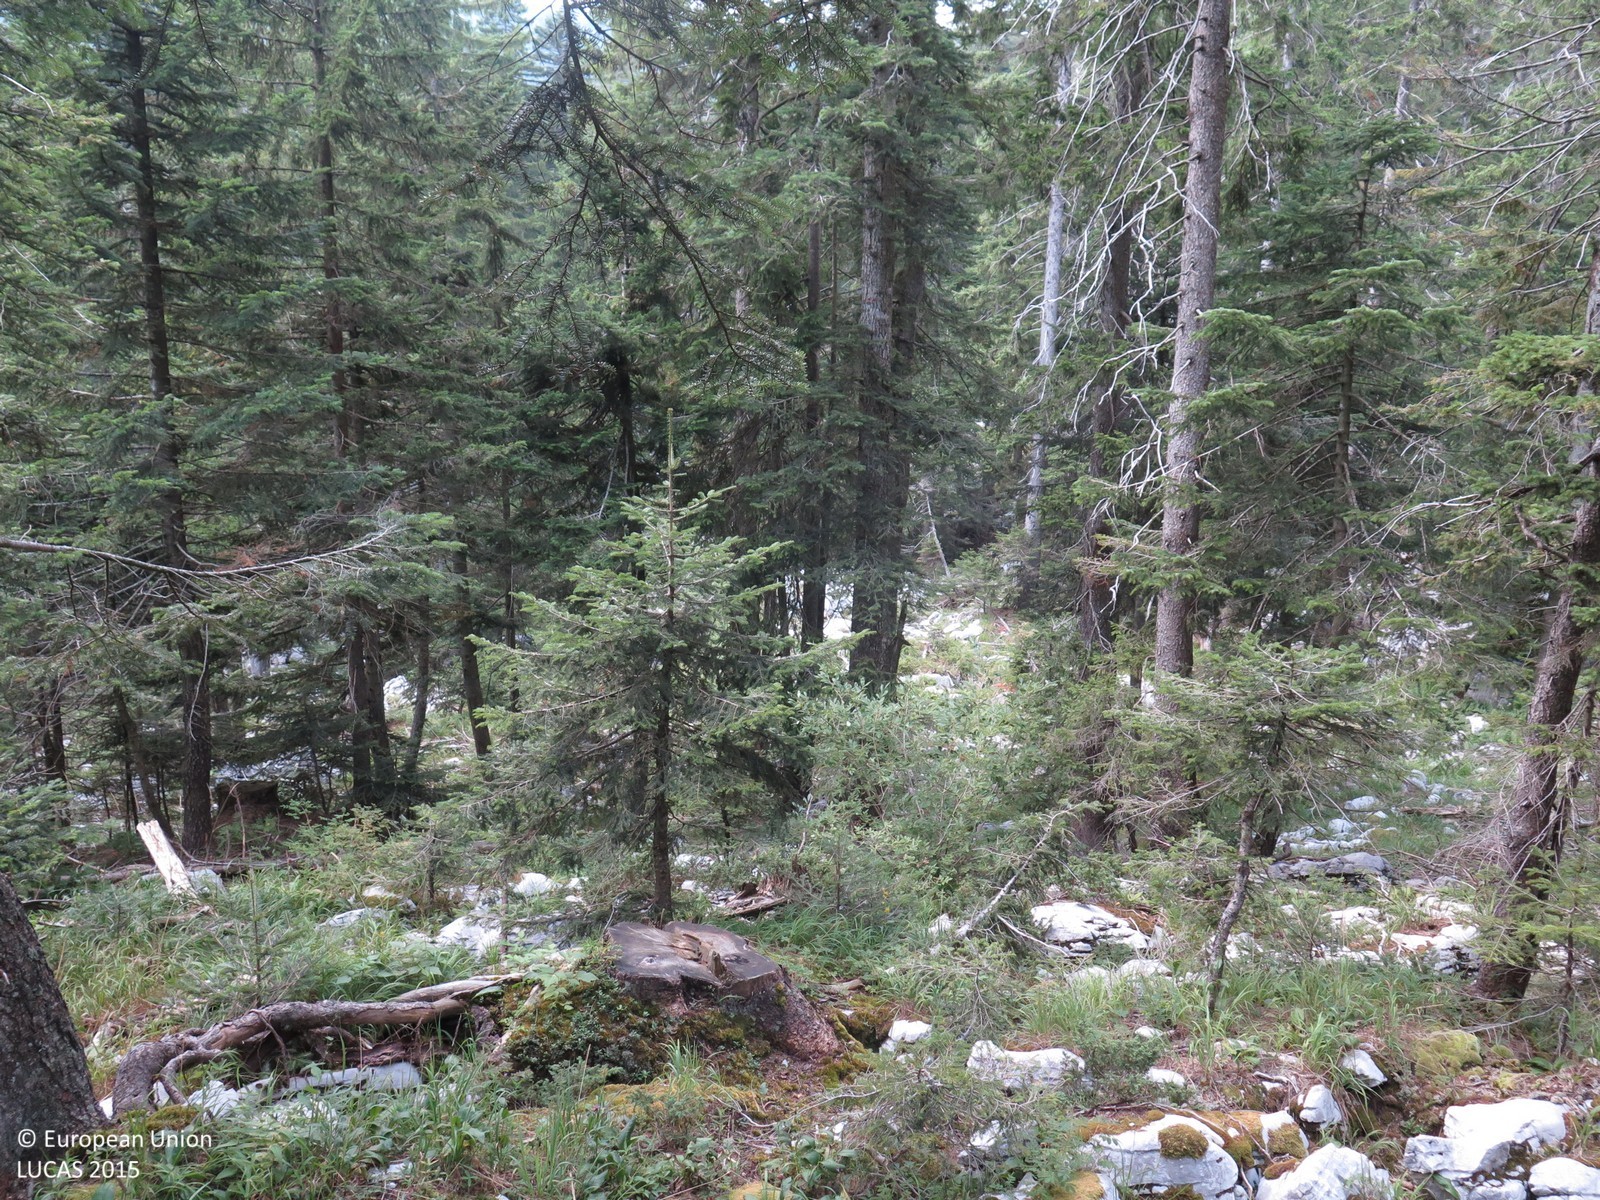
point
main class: Woodland
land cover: Other mixed woodland
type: coniferous forest of the mediterranean region
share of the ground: > 75 %
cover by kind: coniferous forest trees 70 %, broadleaved forest trees 25 %, unconsolidated bare surface 5 %
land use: Forestry
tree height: > 5 m
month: August
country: HR
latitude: 45.4960
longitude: 14.5638
